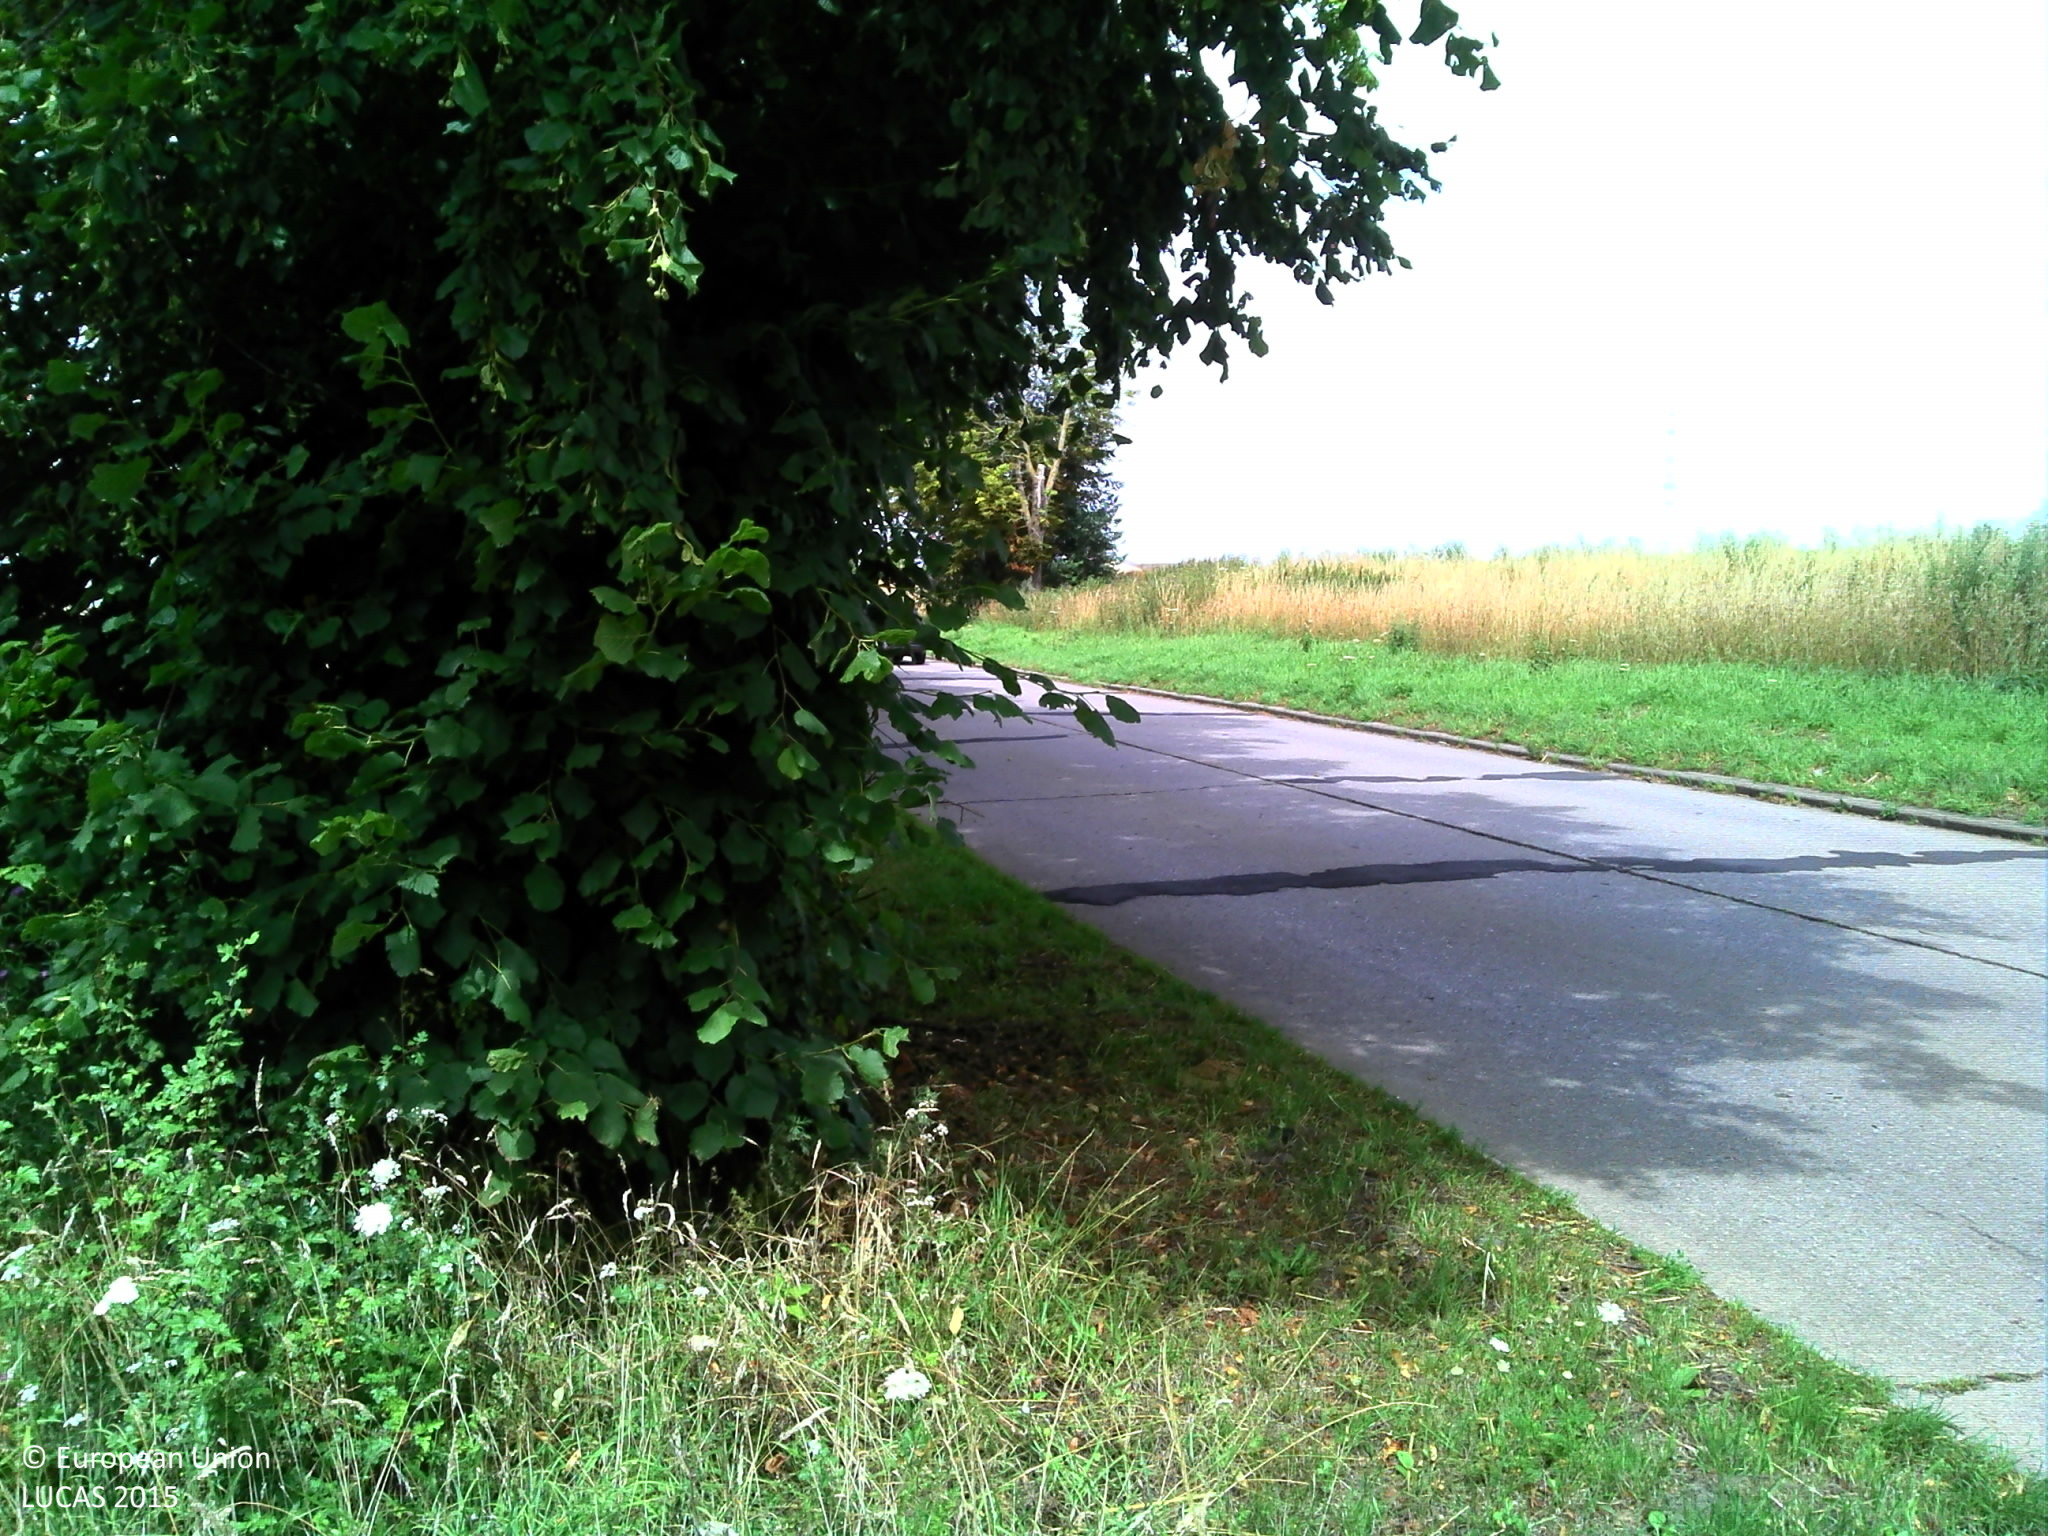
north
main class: Woodland
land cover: Broadleaved woodland
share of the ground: > 75 %
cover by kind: broadleaved forest trees 60 %, herbaceous plants 40 %
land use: Semi-natural and natural areas not in use
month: July
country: BE
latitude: 50.4945
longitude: 4.3426
